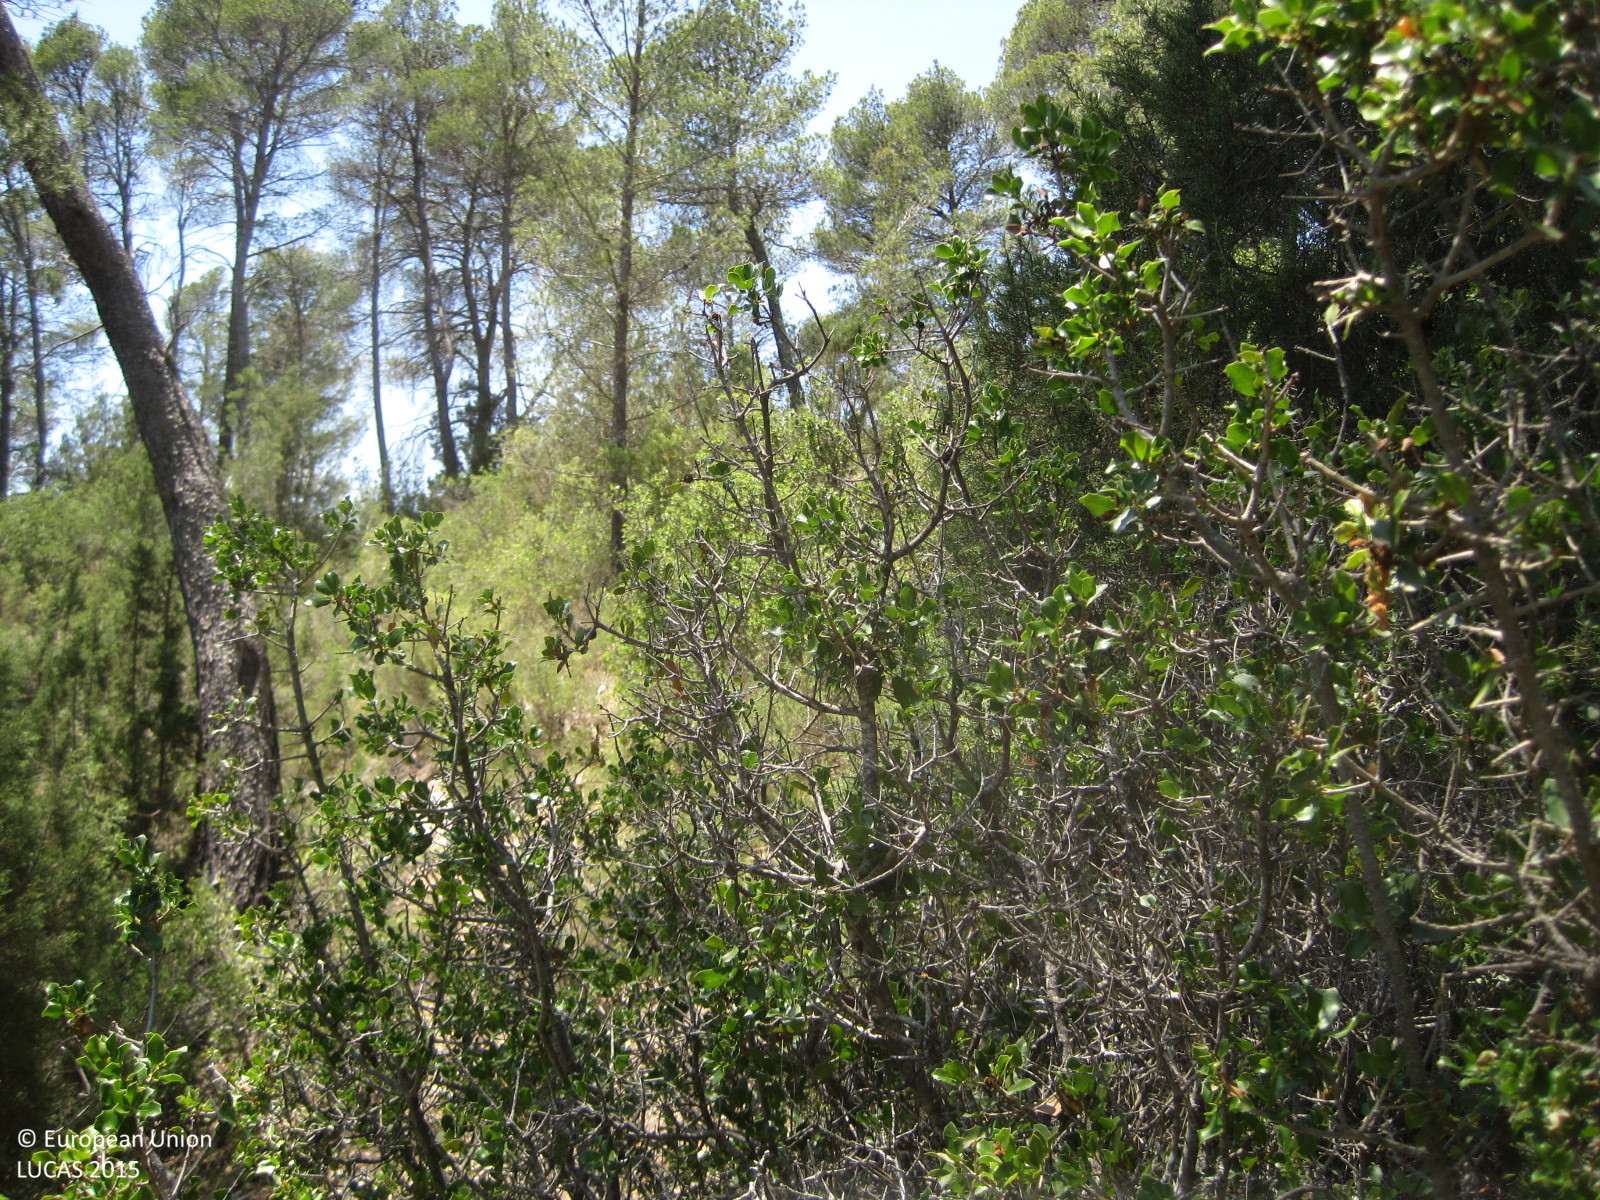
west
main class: Woodland
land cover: Pine dominated coniferous woodland
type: coniferous forest of the mediterranean region
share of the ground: 25 - 50 %
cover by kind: coniferous forest trees 40 %, shrubs 35 %, consolidated bare surface 15 %, herbaceous plants 10 %
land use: Forestry
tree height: > 5 m
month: June
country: ES
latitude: 39.7725
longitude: -1.1776
